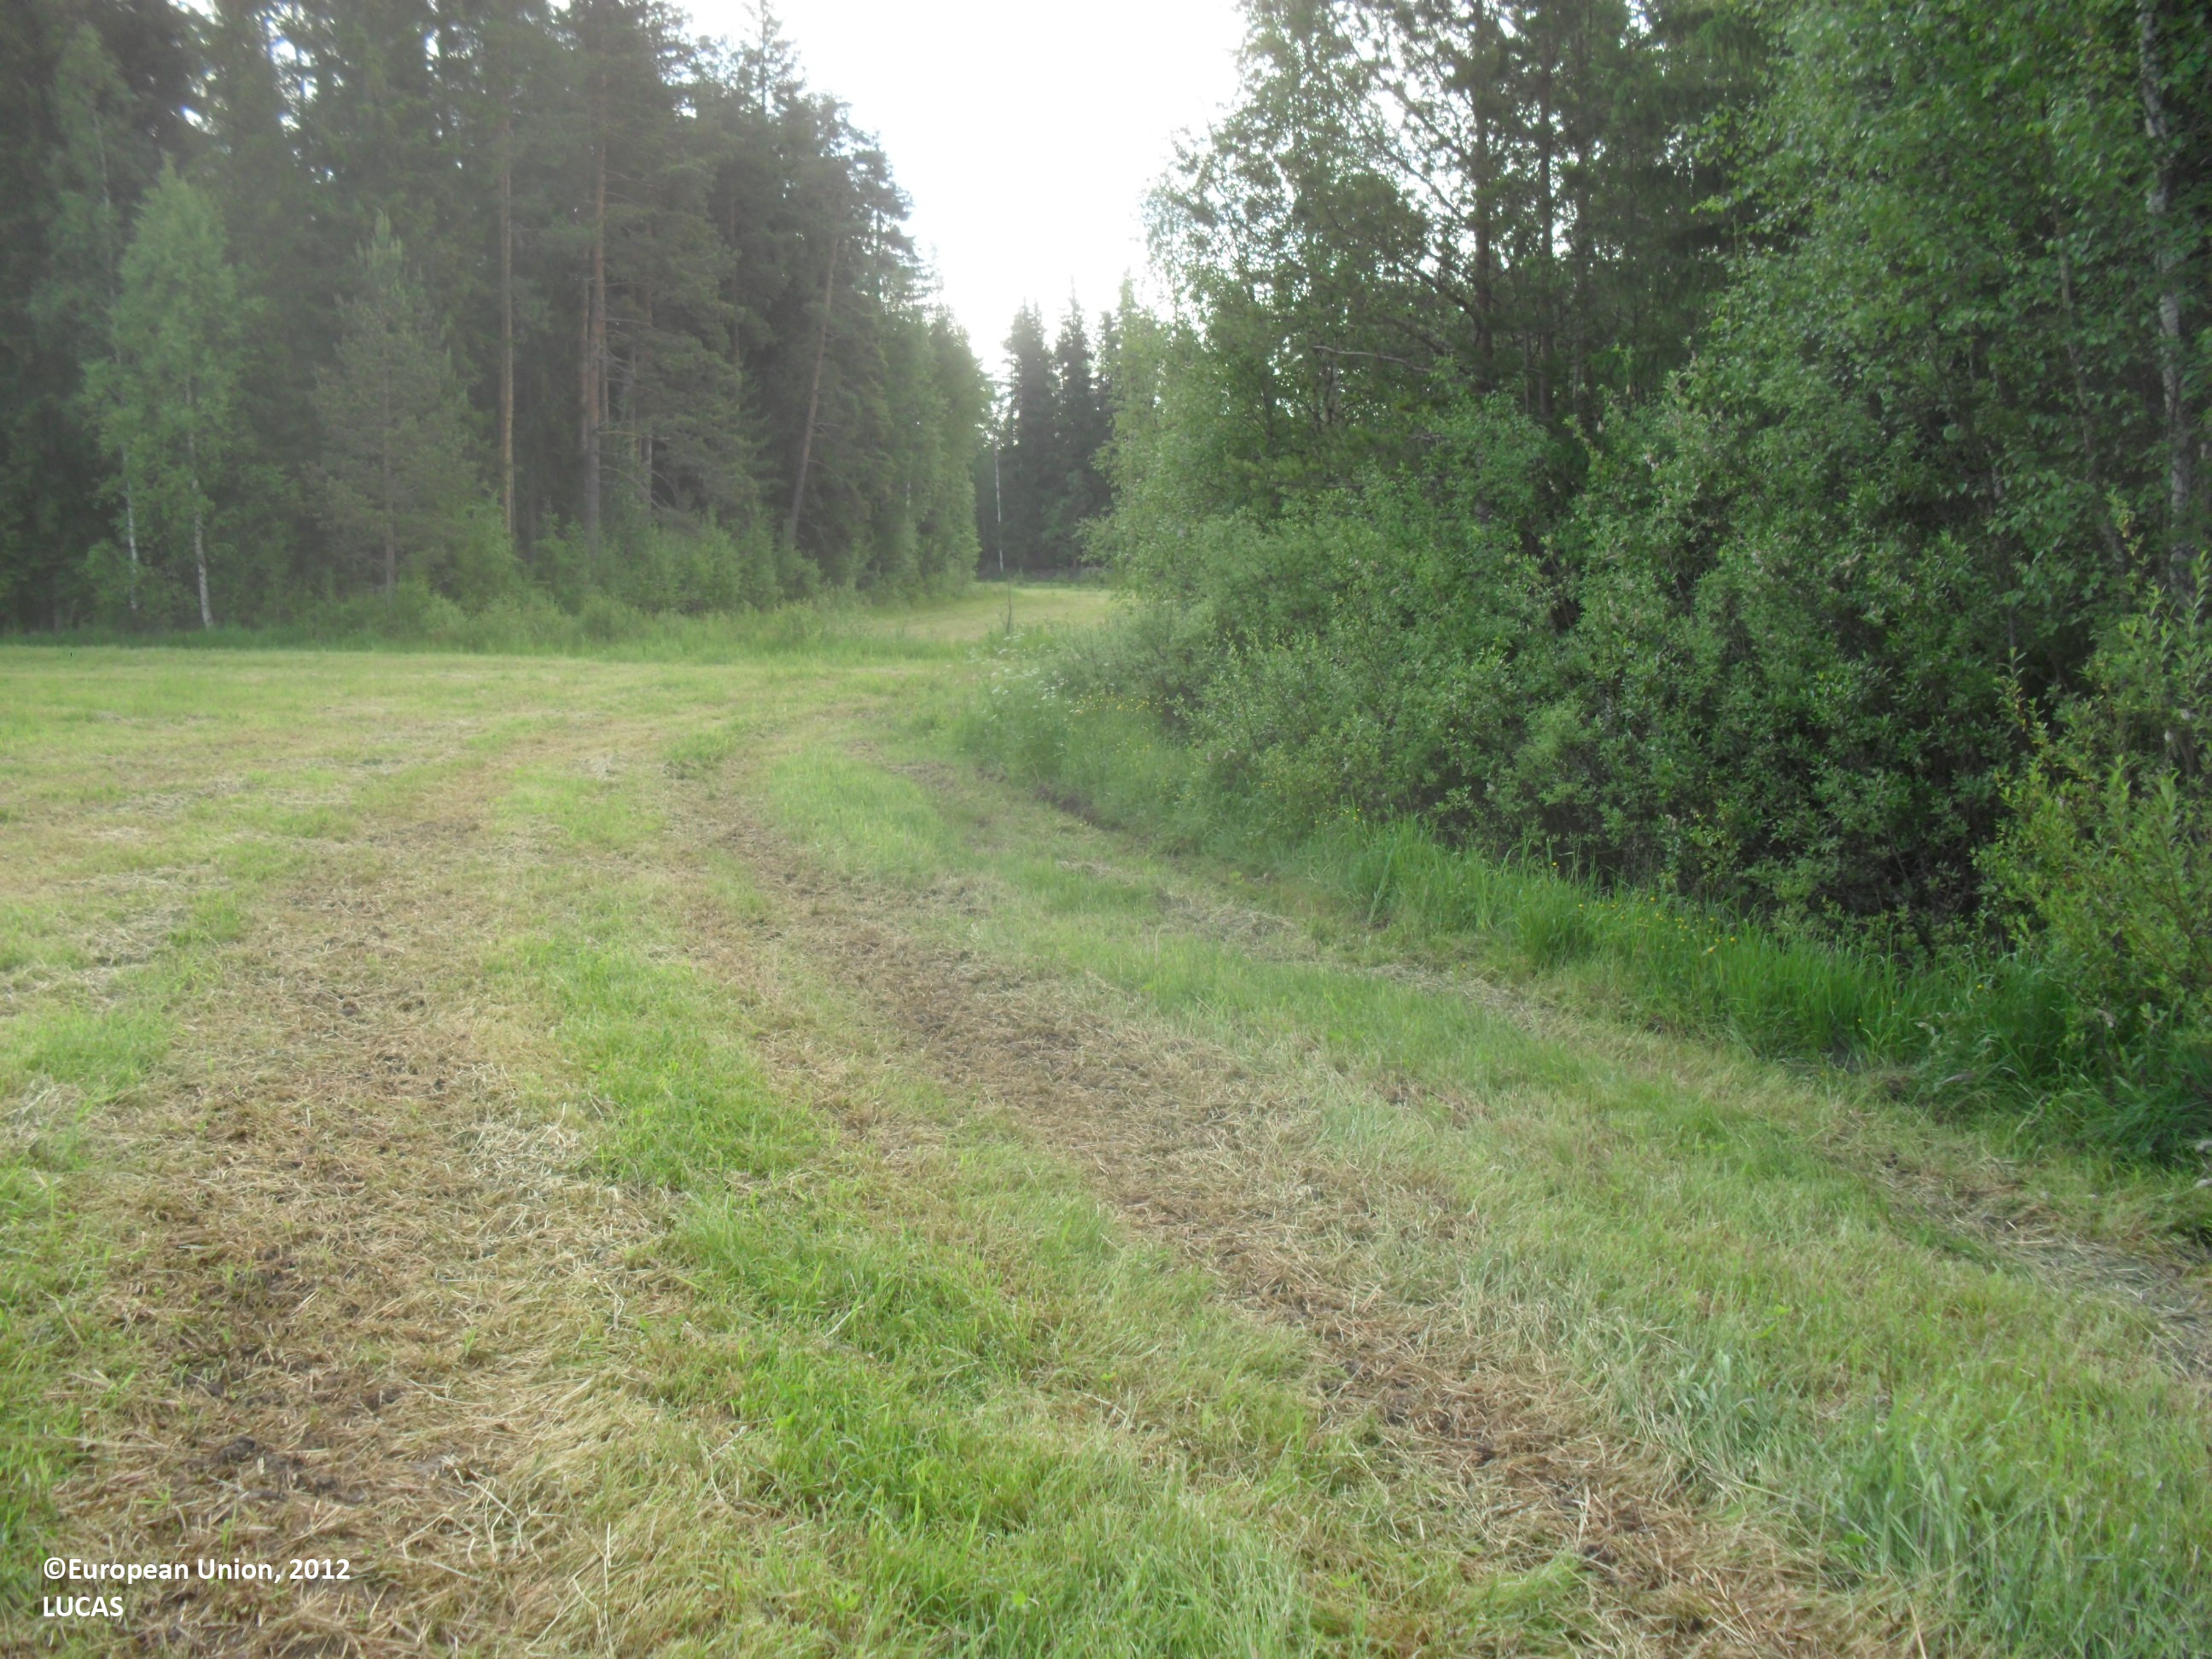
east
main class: Cropland
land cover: Temporary grasslands
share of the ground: > 75 %
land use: Agriculture (excluding fallow land and kitchen gardens)
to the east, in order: Temporary grasslands; Grassland without tree/shrub cover; Ditches and canals; Temporary grasslands; Rivers and streams; Temporary grasslands; Ditches and canals; Other mixed woodland; Tracks; Pine dominated mixed woodland; Pine dominated coniferous woodland; Tracks; Pine dominated coniferous woodland; Pine dominated mixed woodland
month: June
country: FI
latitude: 63.3006
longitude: 23.3271
